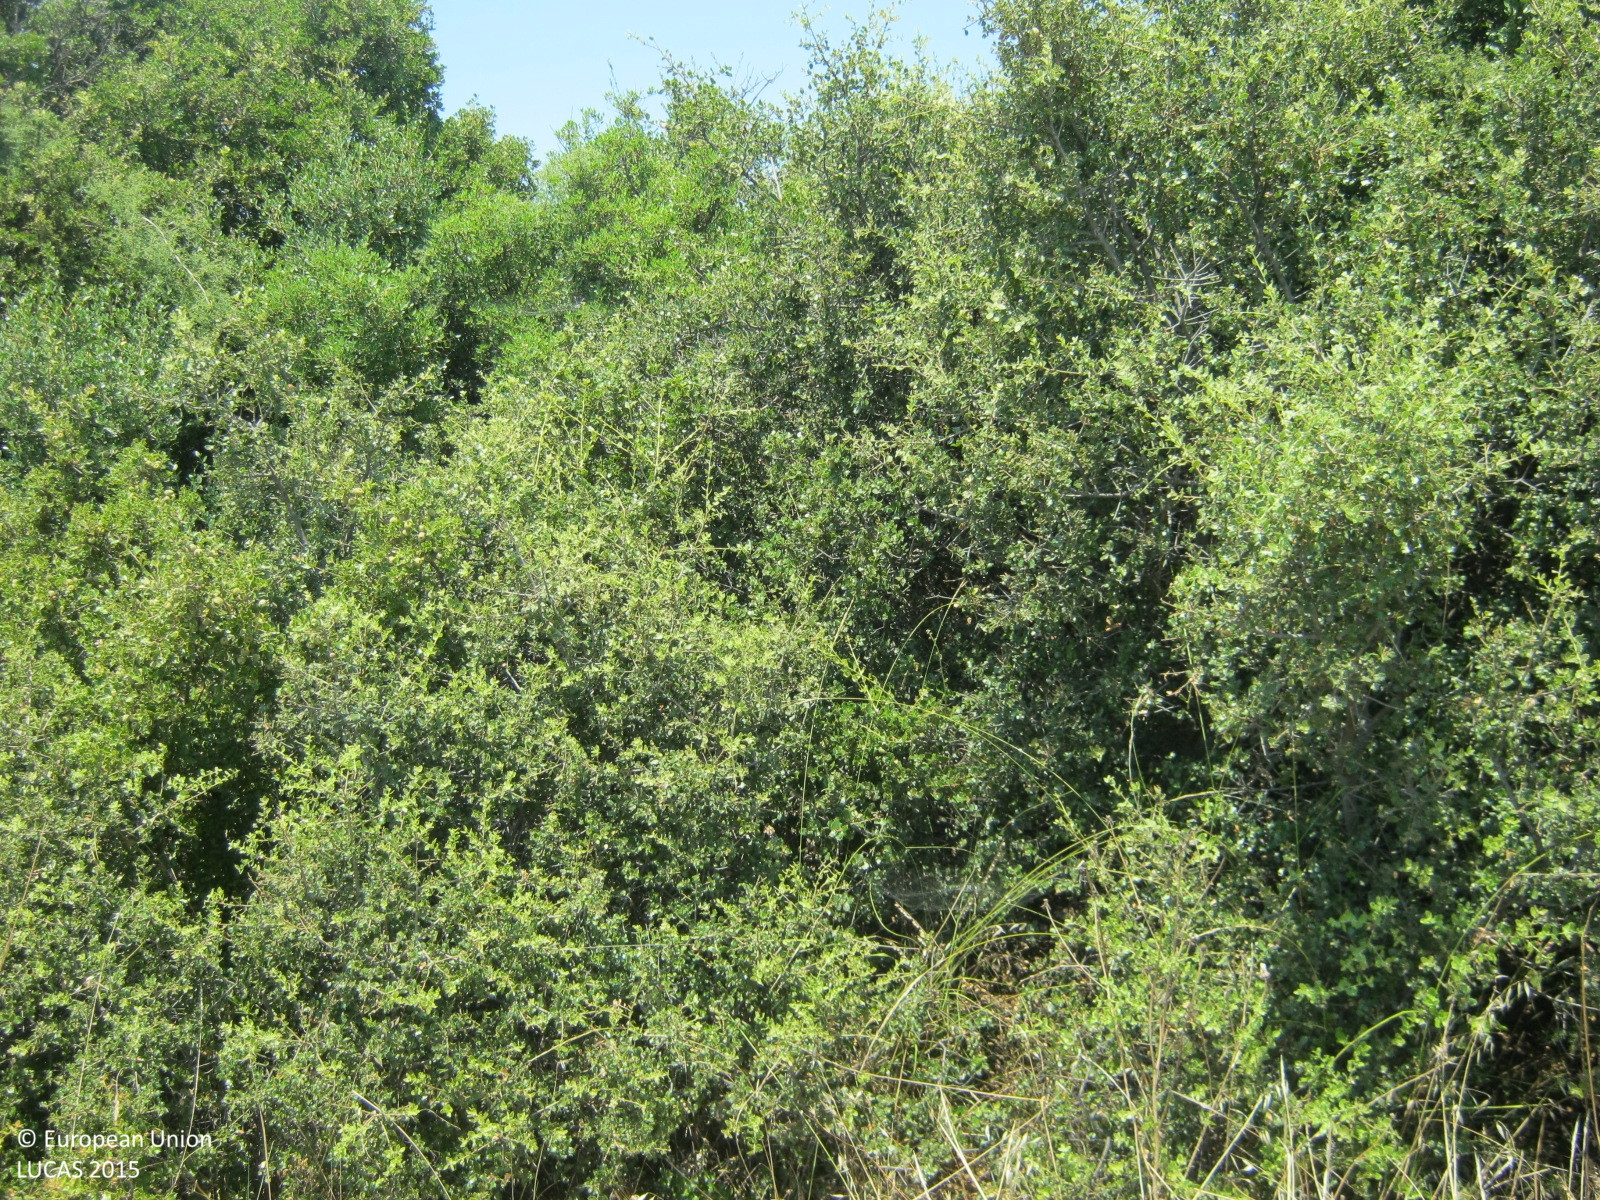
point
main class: Shrubland
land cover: Shrubland with sparse tree cover
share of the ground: > 75 %
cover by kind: shrubs 95 %, broadleaved forest trees 5 %
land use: Semi-natural and natural areas not in use
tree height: < 5 m
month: July
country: GR
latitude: 40.3565
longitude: 23.0872
